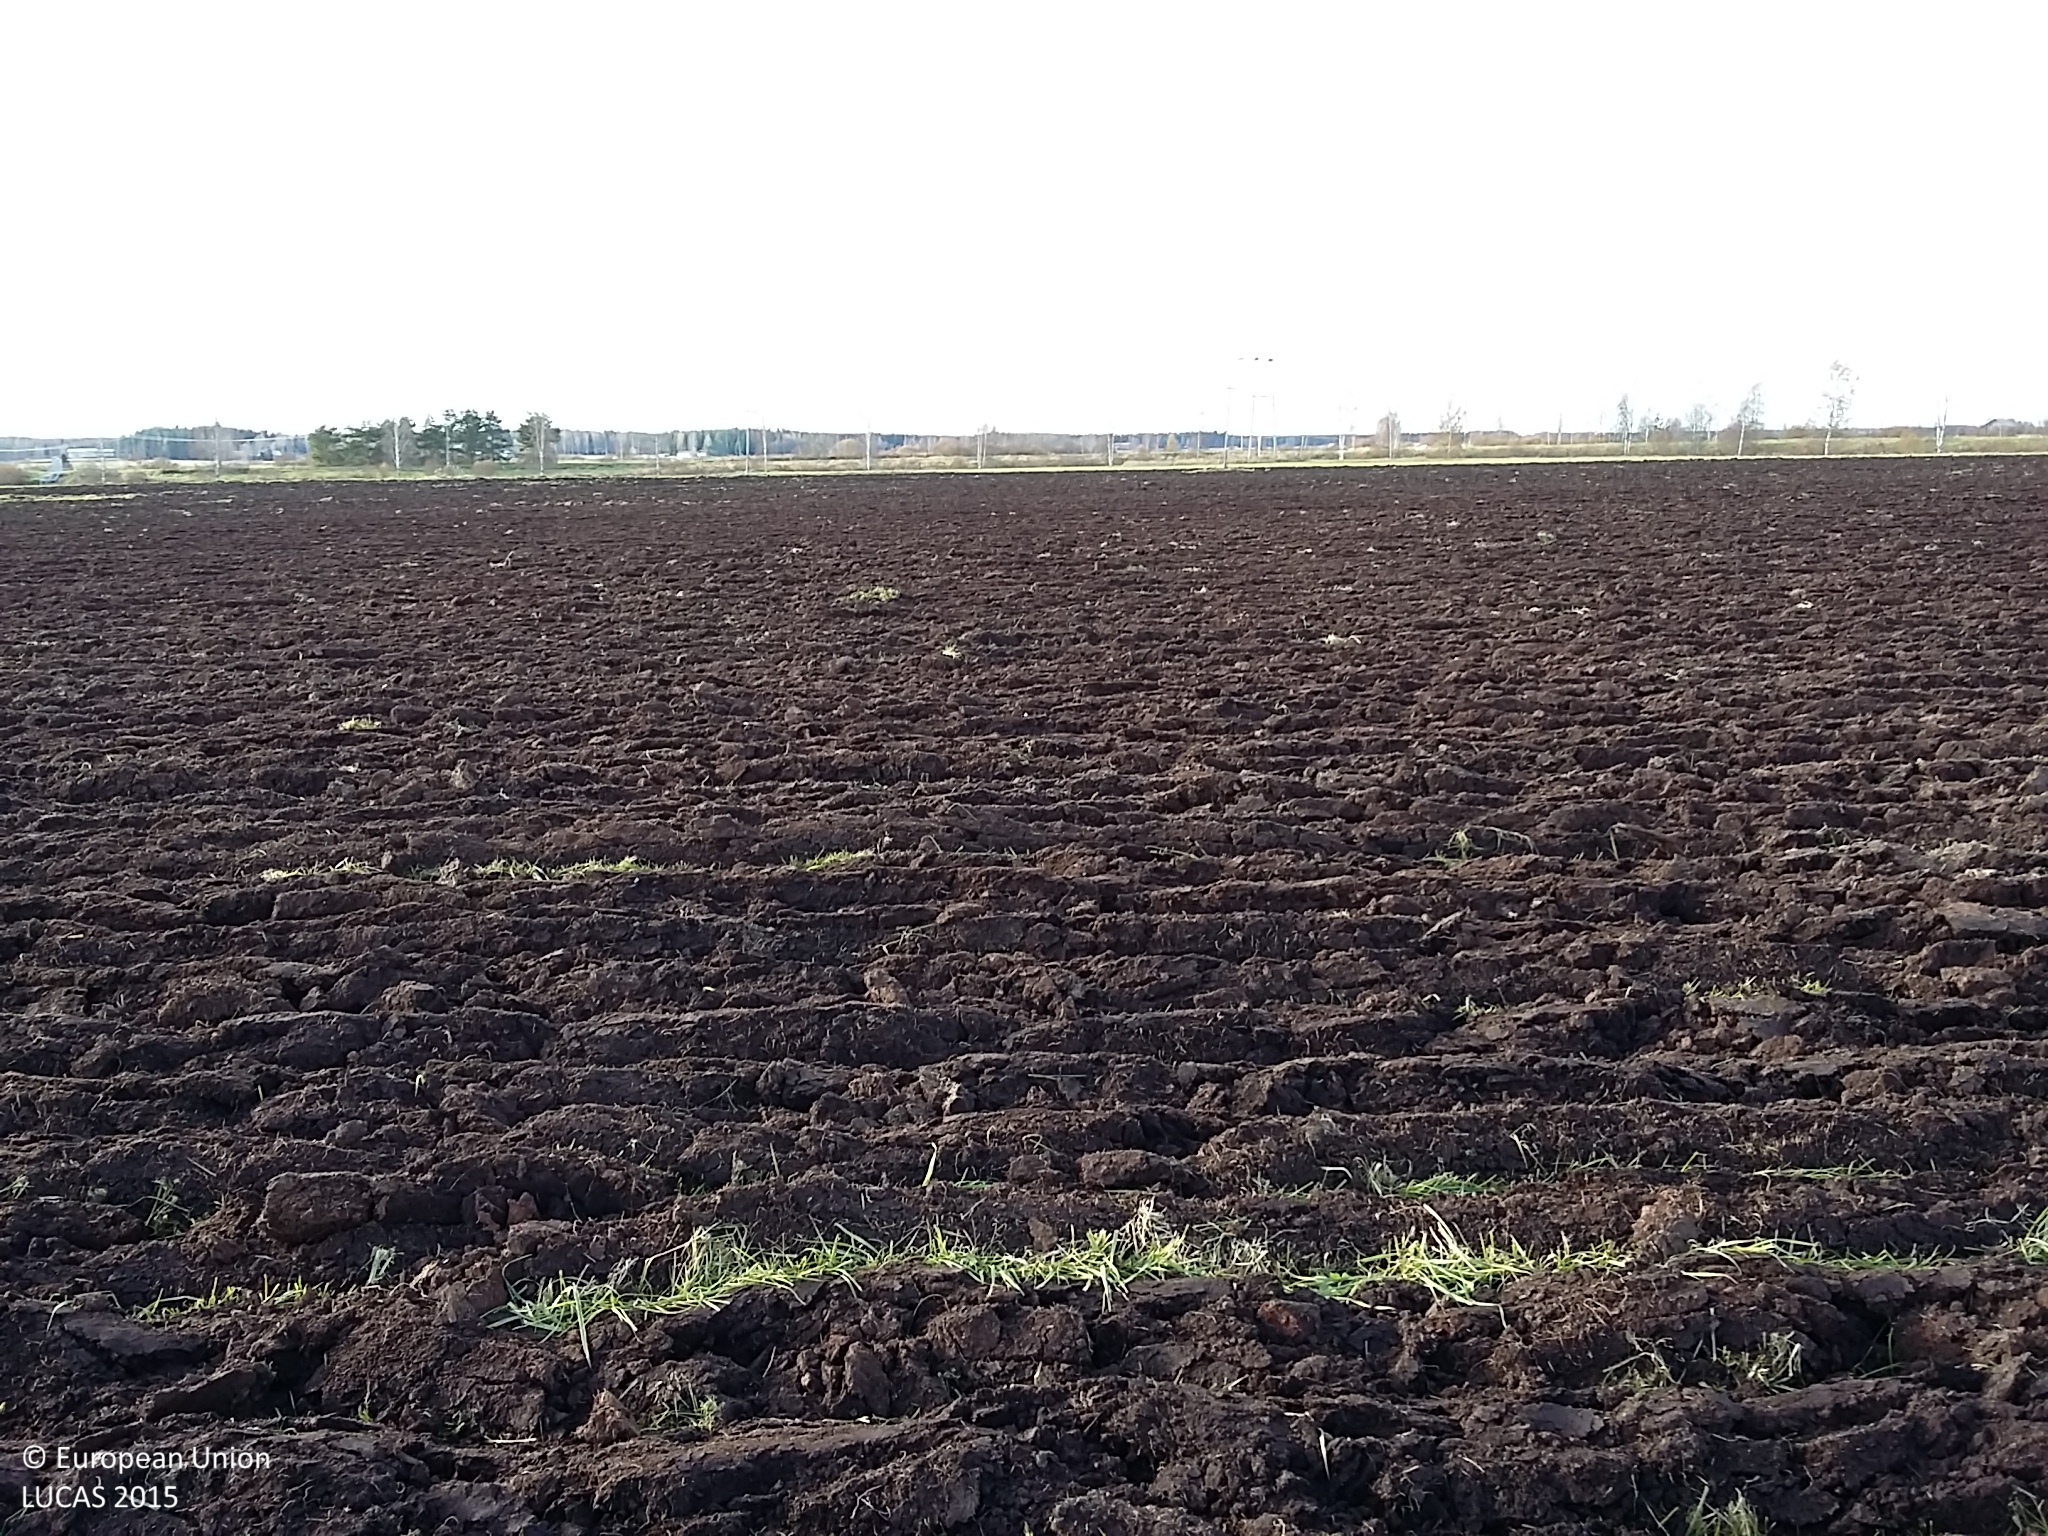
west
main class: Cropland
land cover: Temporary grasslands
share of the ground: > 75 %
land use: Agriculture (excluding fallow land and kitchen gardens)
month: October
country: FI
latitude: 63.9280
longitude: 24.9097
